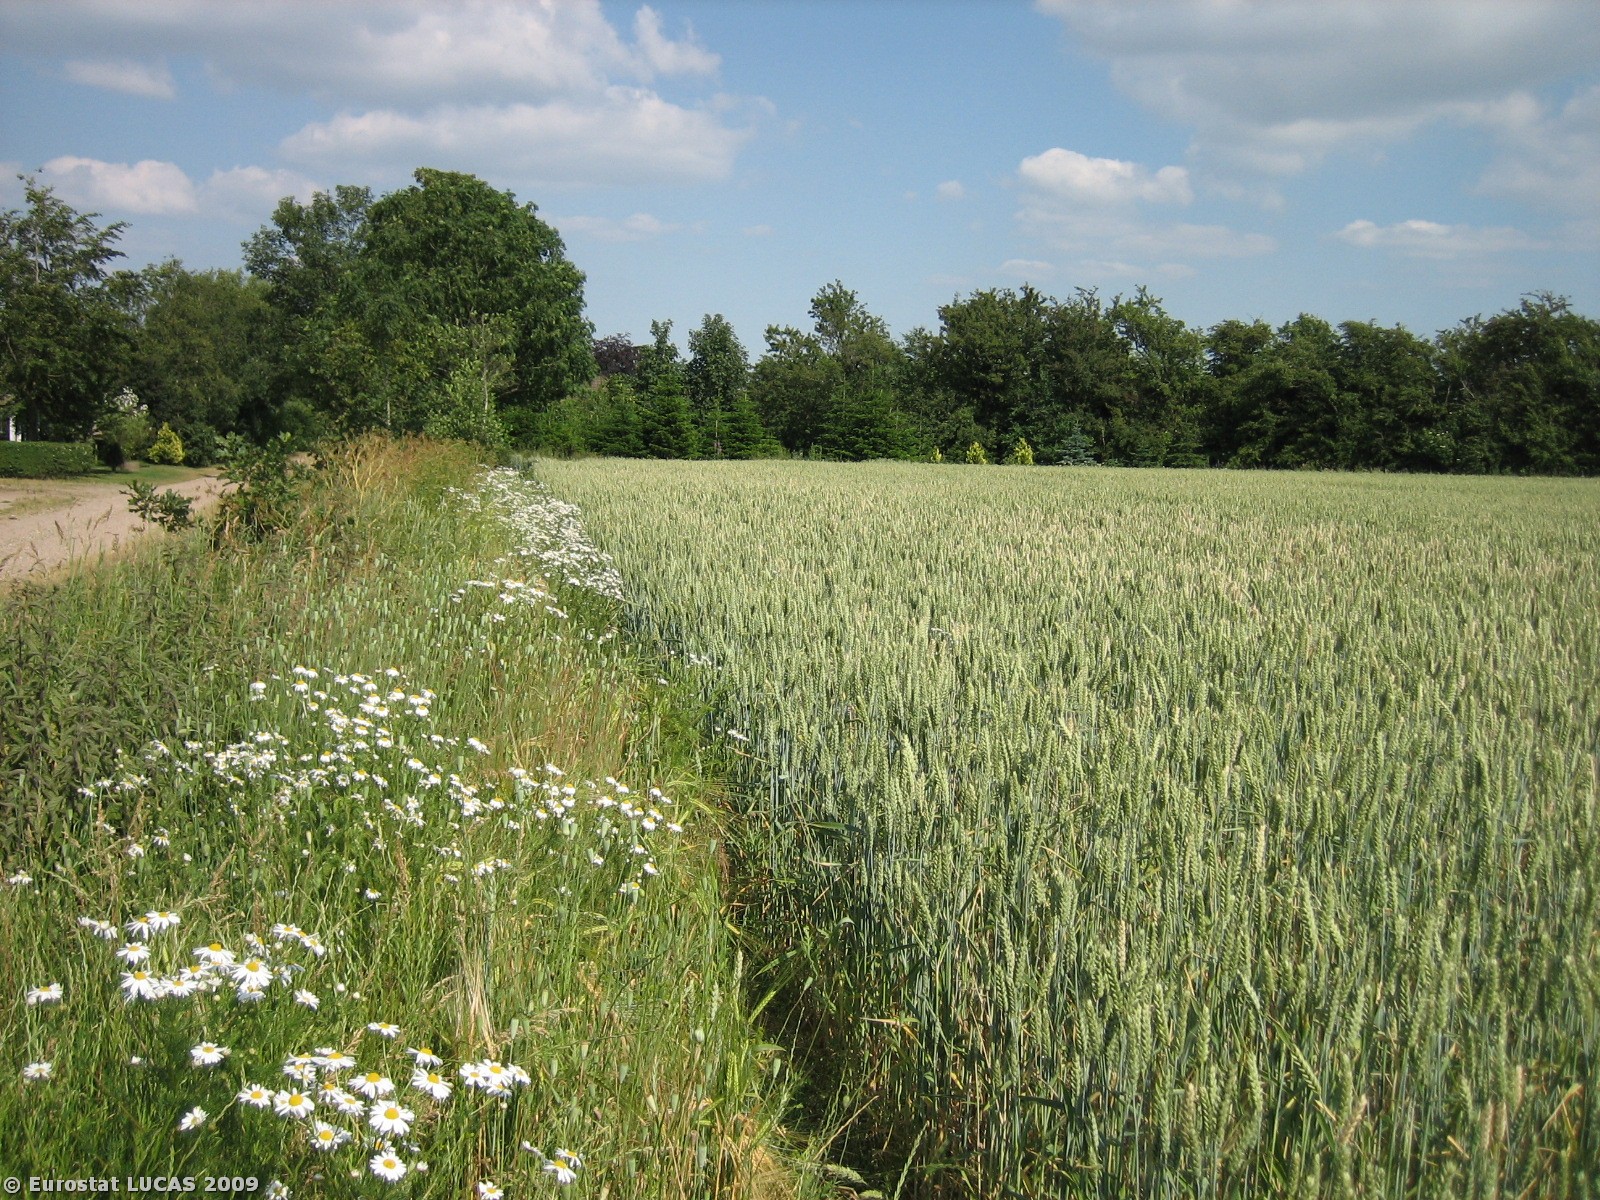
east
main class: Cropland
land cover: Common wheat
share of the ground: > 75 %
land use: Agriculture (excluding fallow land and kitchen gardens)
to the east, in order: Common wheat; Broadleaved woodland; Arable land (only in case pi)
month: July
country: DK
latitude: 55.3570
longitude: 9.0071
